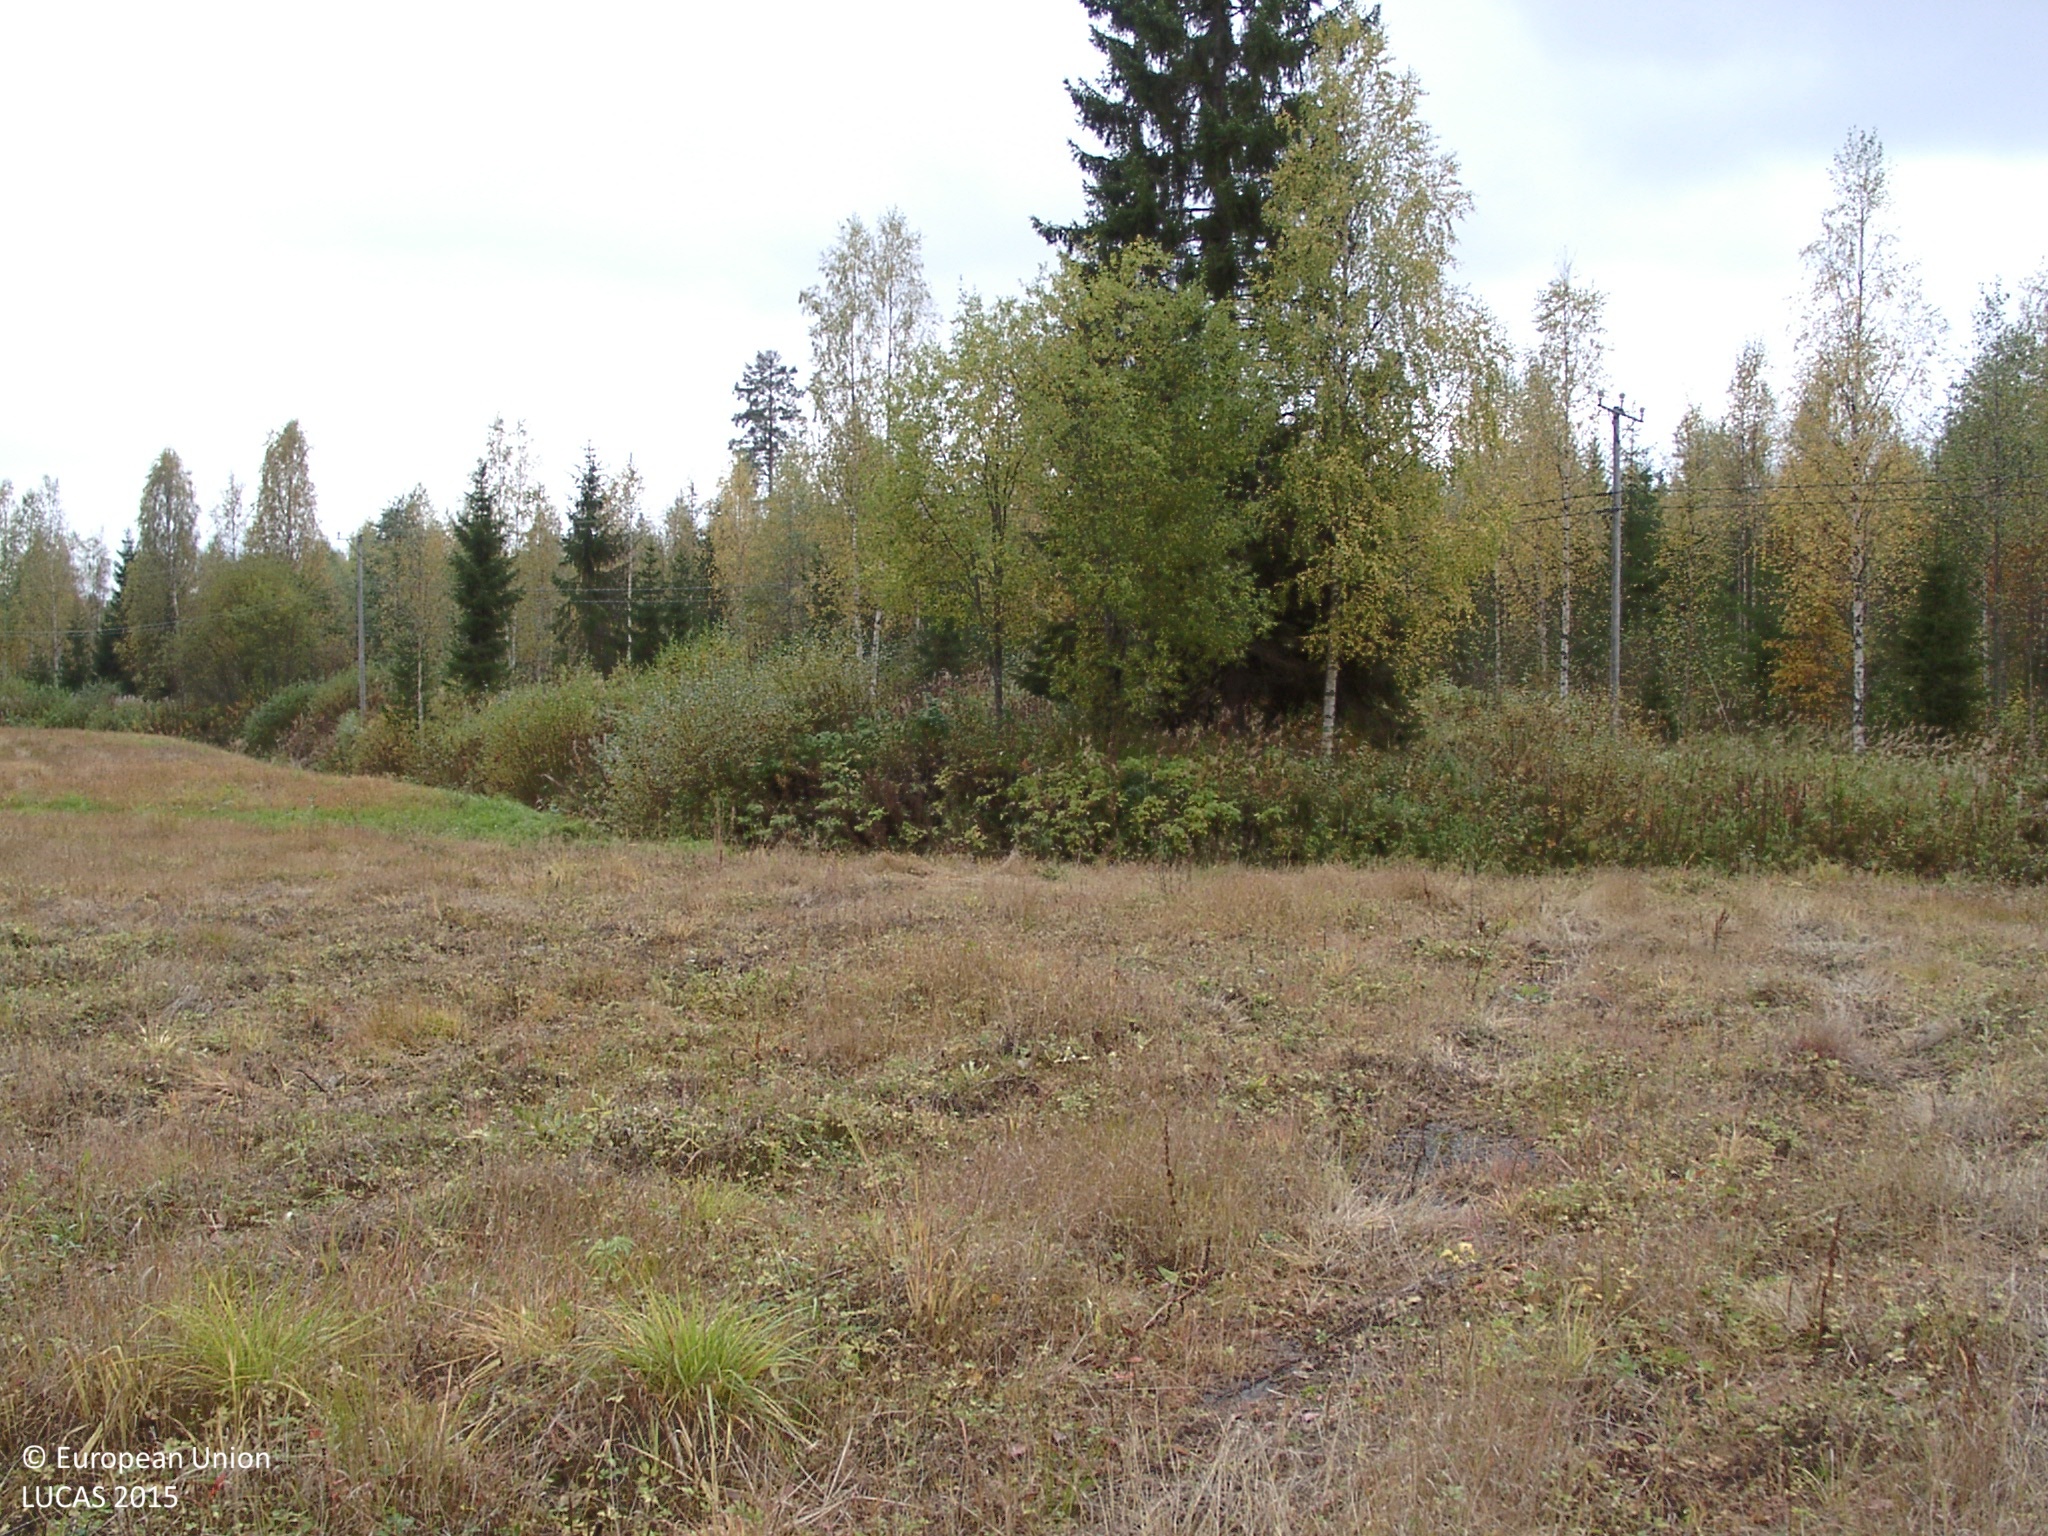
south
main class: Grassland
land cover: Spontaneously vegetated surfaces
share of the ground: > 75 %
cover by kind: herbaceous plants 100 %
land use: Fallow land
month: September
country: FI
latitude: 62.6000
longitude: 25.2788
